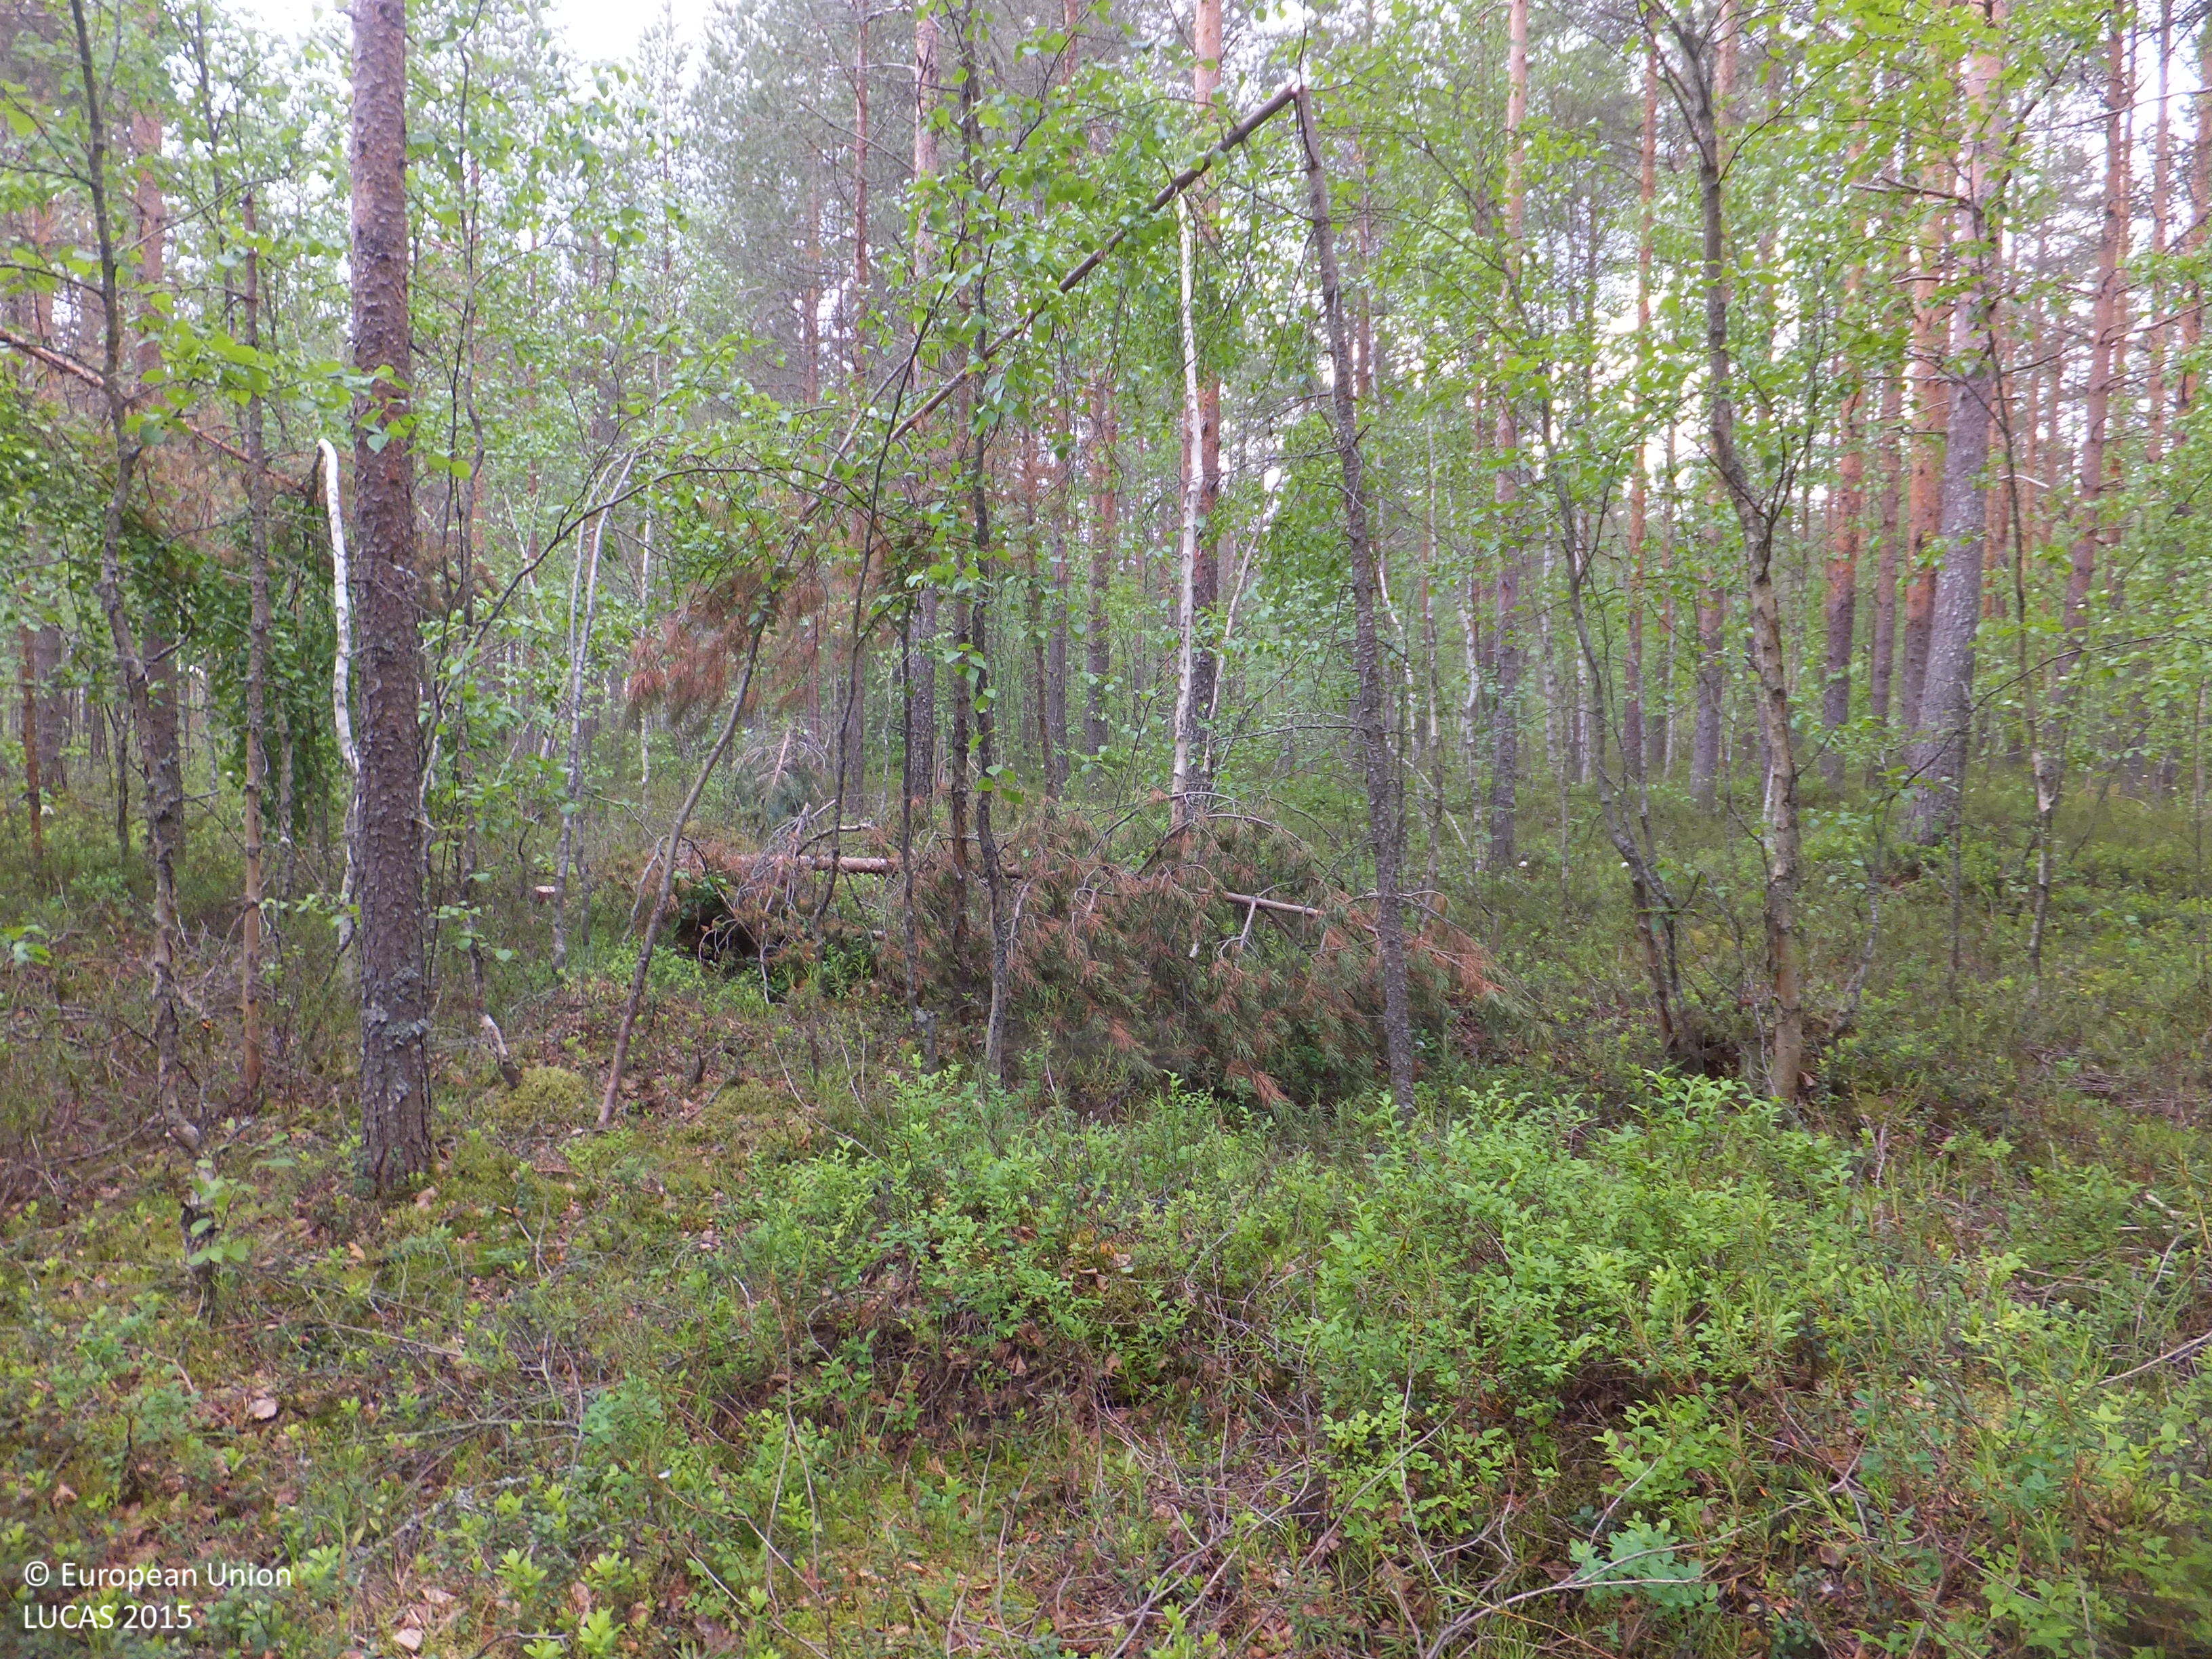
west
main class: Woodland
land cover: Pine dominated mixed woodland
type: boreal forest
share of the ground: > 75 %
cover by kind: coniferous forest trees 45 %, broadleaved forest trees 25 %, shrubs 20 %, lichens and mosses 10 %
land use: Forestry
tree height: > 5 m
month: June
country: FI
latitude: 63.5265
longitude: 24.0860
